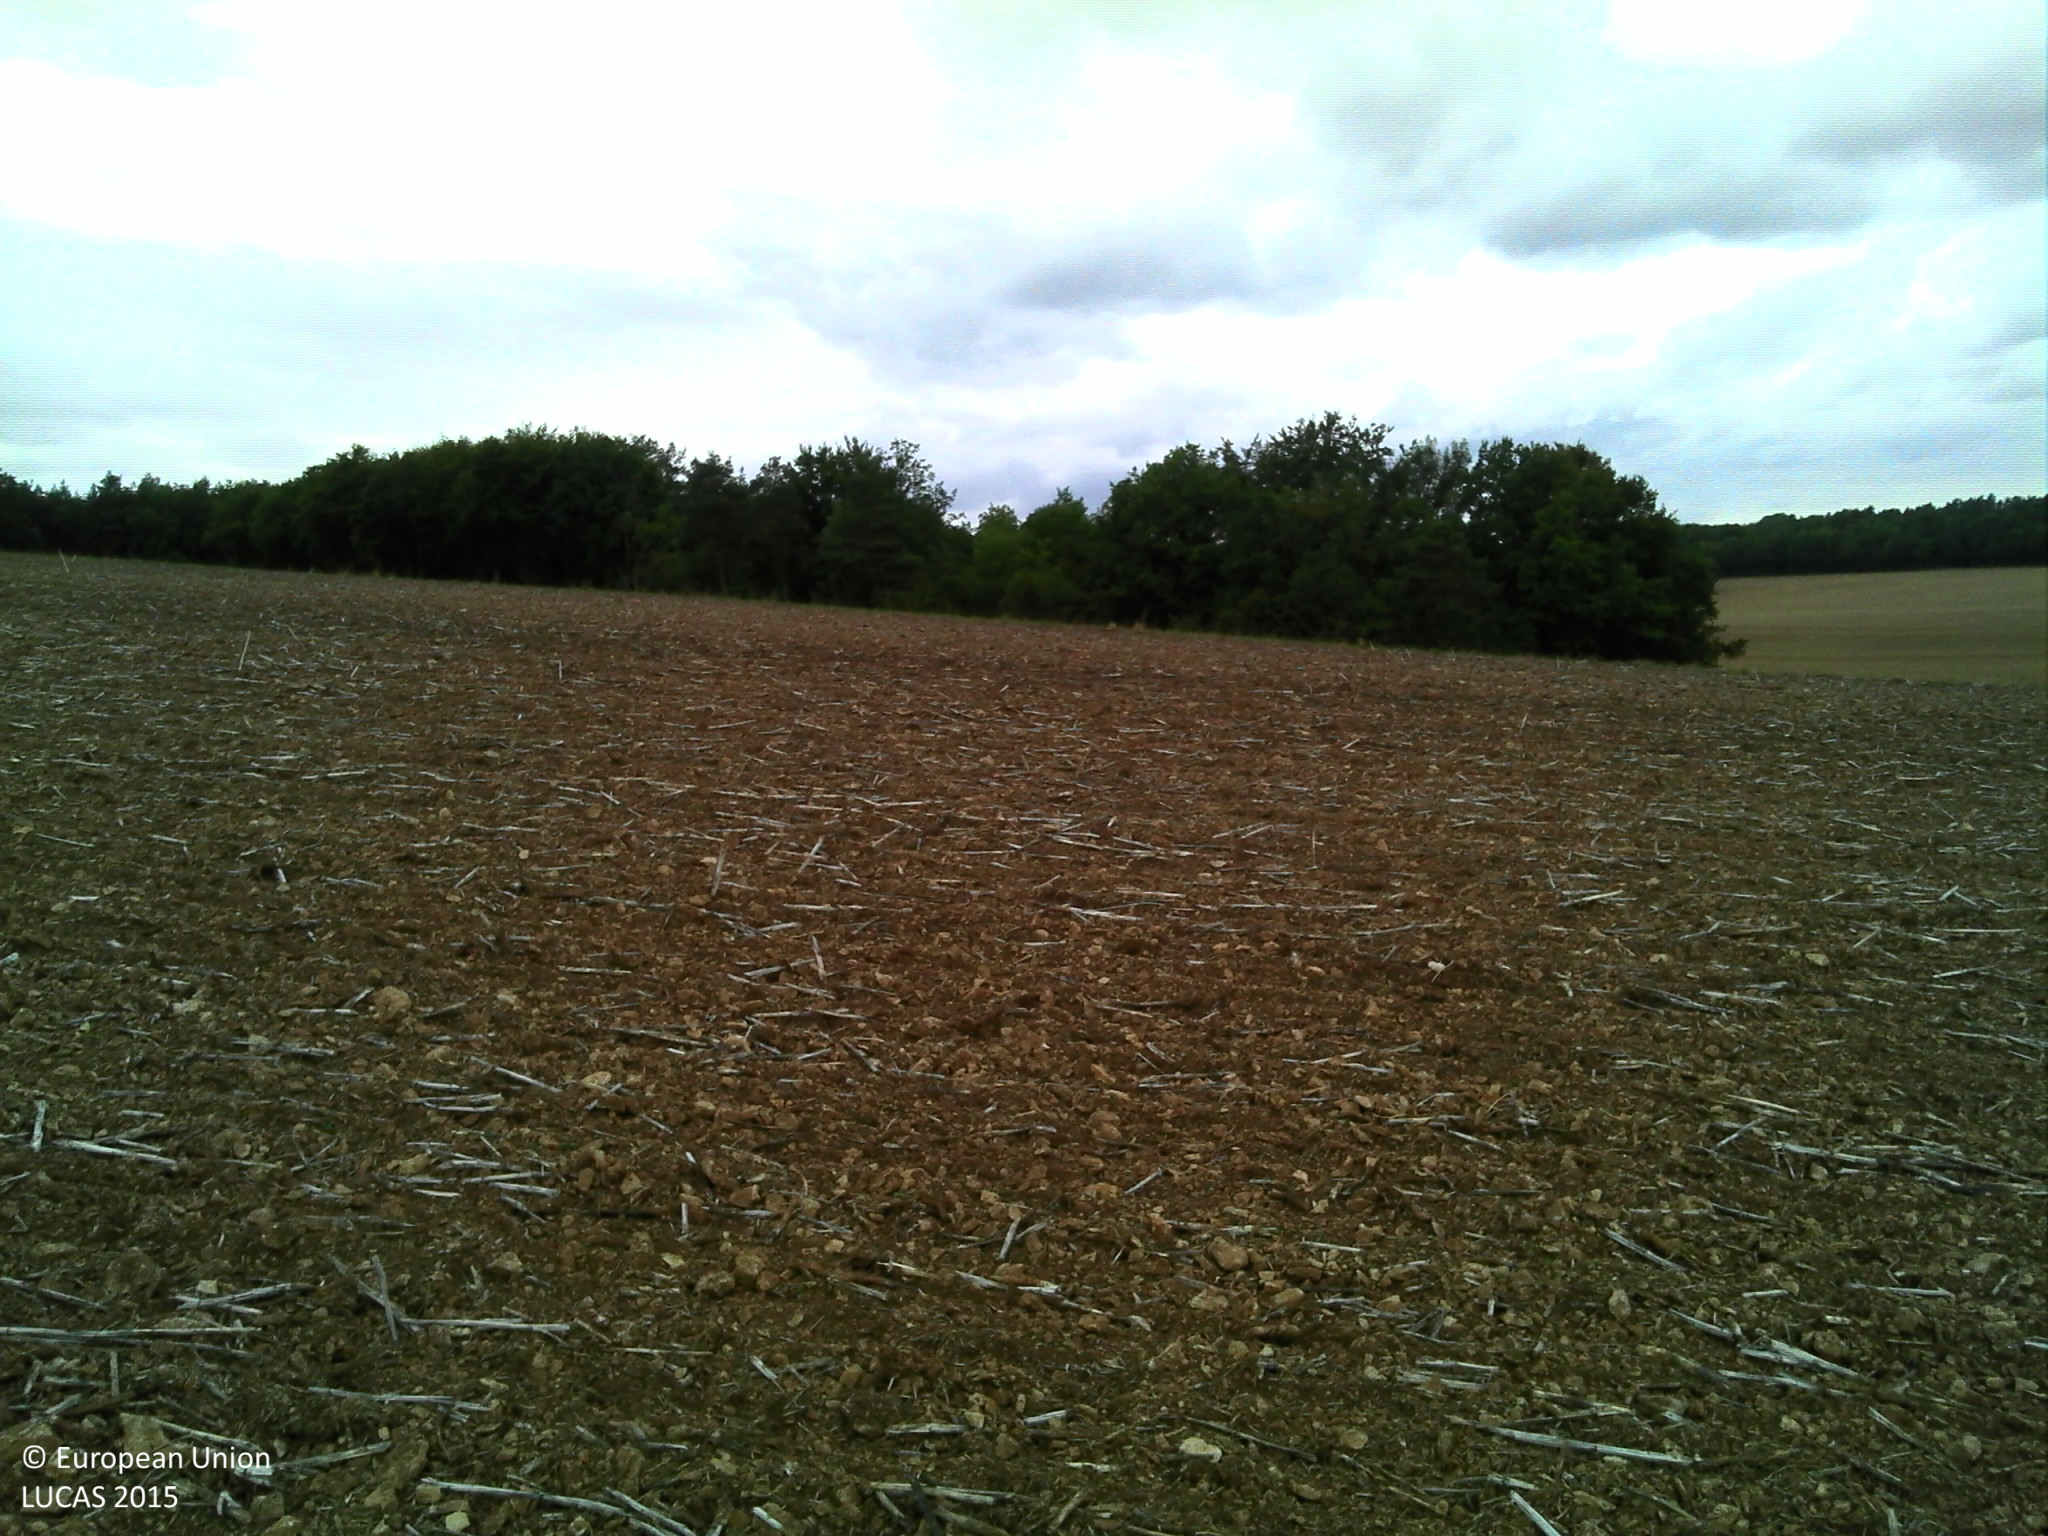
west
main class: Cropland
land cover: Rape and turnip rape
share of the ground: 25 - 50 %
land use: Agriculture (excluding fallow land and kitchen gardens)
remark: Tilled/Sowed
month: August
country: FR
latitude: 47.7215
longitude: 4.7867
